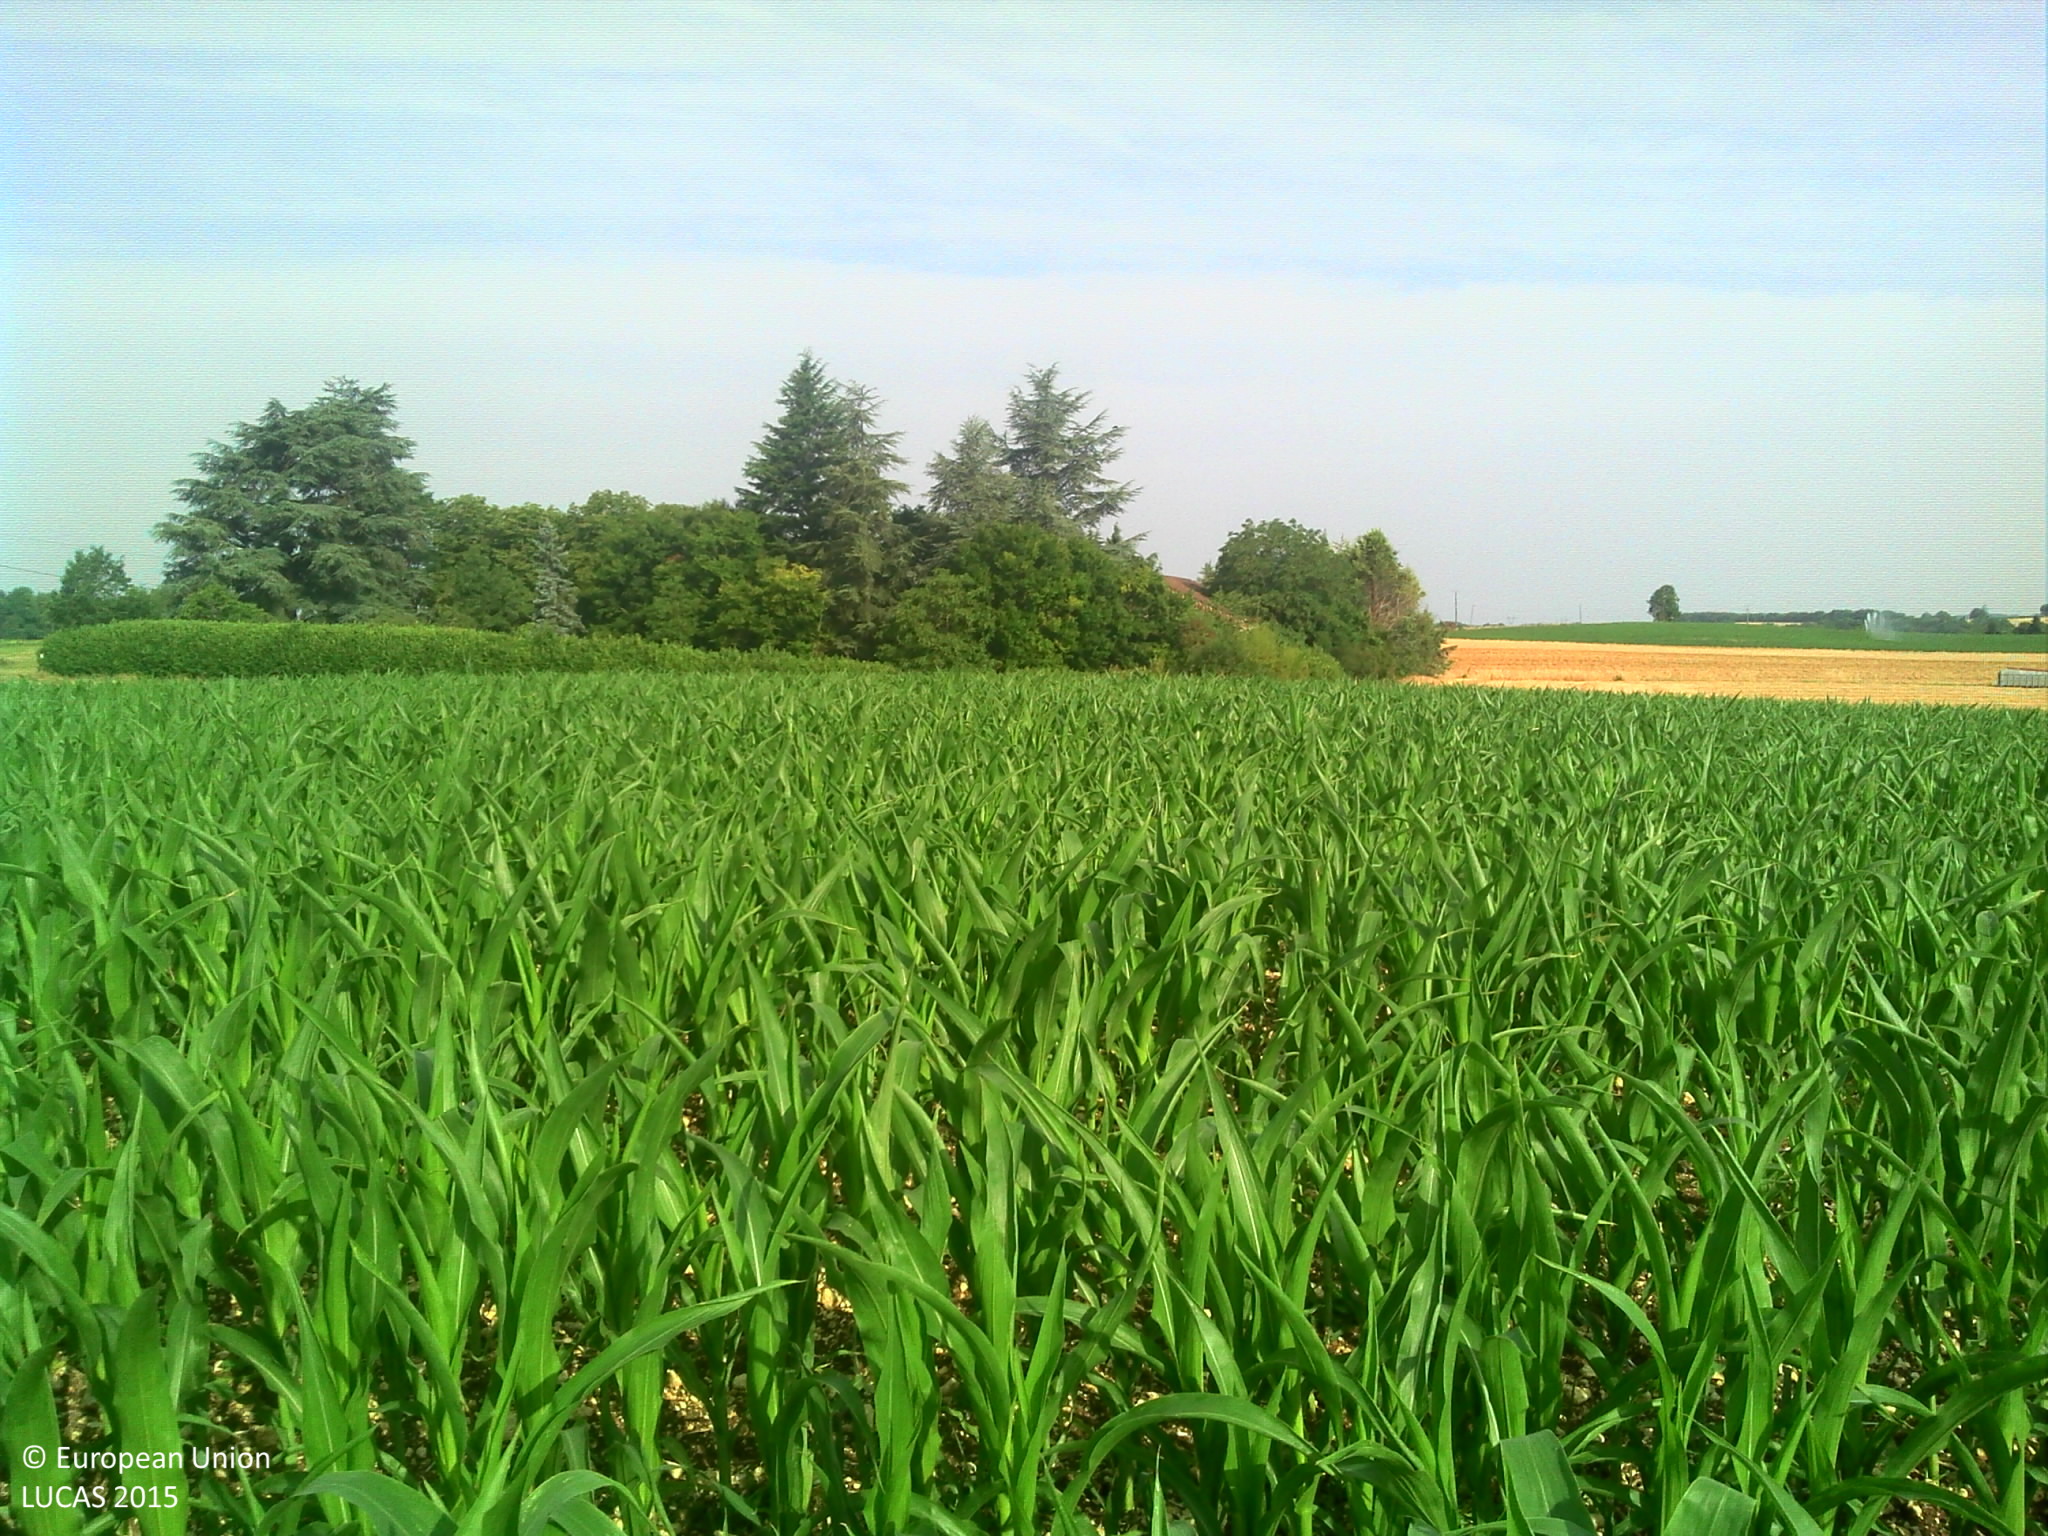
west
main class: Cropland
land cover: Maize
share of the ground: > 75 %
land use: Agriculture (excluding fallow land and kitchen gardens)
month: July
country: FR
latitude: 44.3335
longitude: 0.9285
